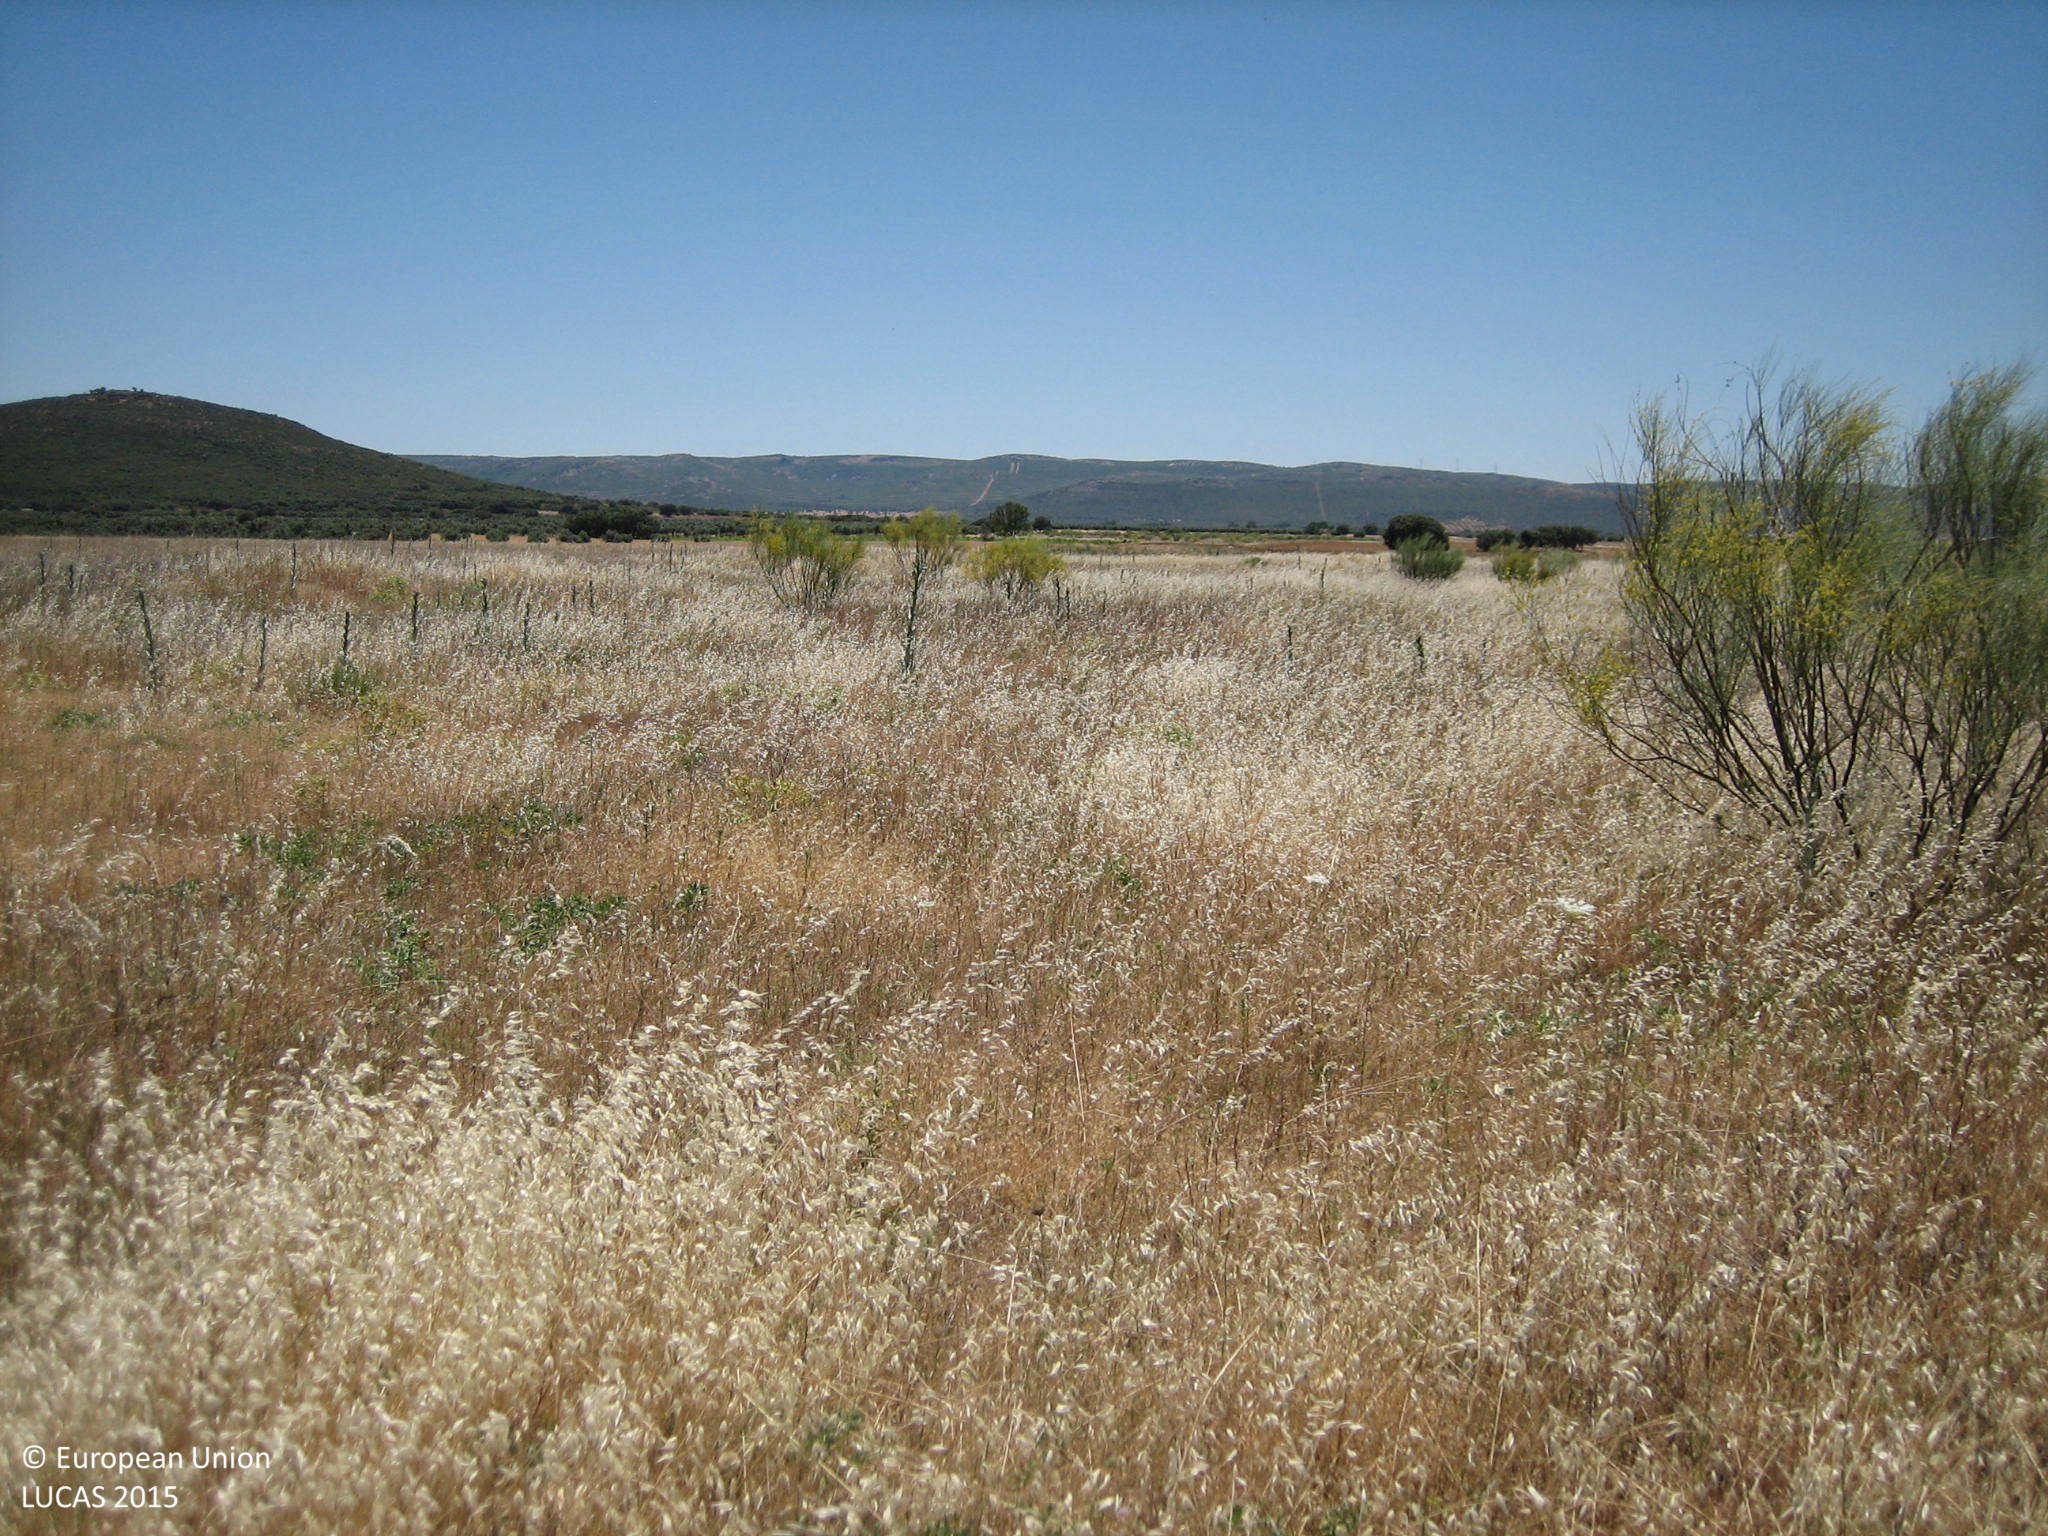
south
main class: Grassland
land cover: Spontaneously vegetated surfaces
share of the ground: > 75 %
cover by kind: herbaceous plants 100 %
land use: Fallow land
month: June
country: ES
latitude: 38.7772
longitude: -4.0271
